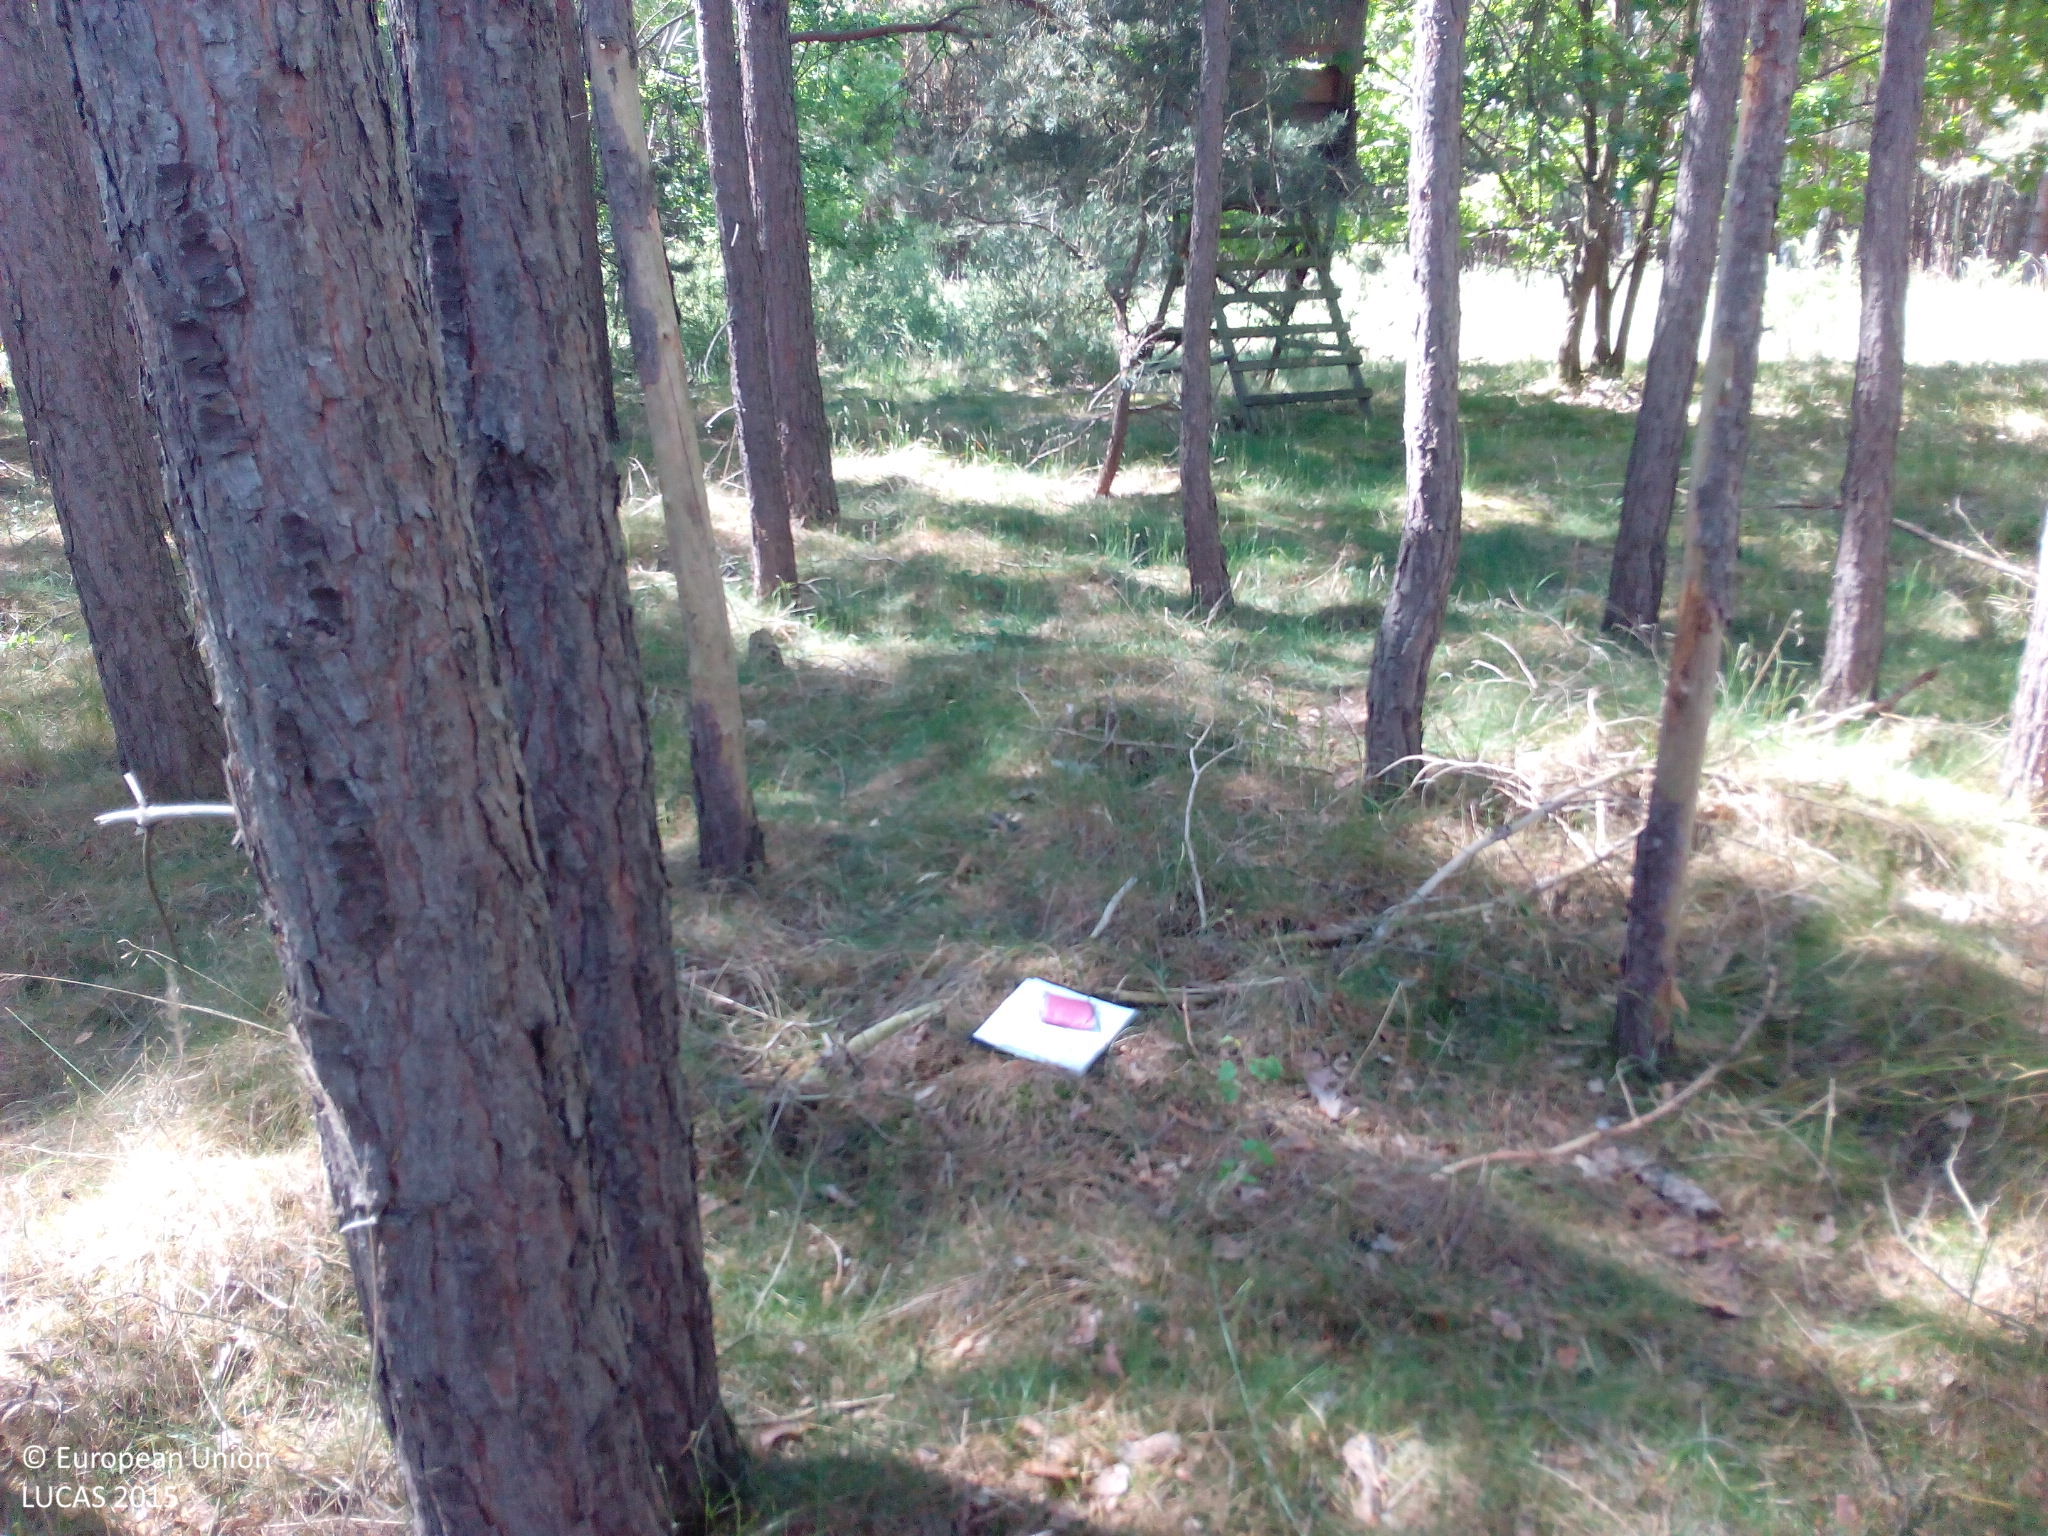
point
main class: Woodland
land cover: Pine dominated coniferous woodland
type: hemiboreal forest and nemoral coniferous forest and mixed broadleaved-coniferous forest
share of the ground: > 75 %
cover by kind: coniferous forest trees 90 %, herbaceous plants 5 %, lichens and mosses 5 %
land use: Forestry
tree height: > 5 m
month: June
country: DE
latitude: 52.3491
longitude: 12.5981
